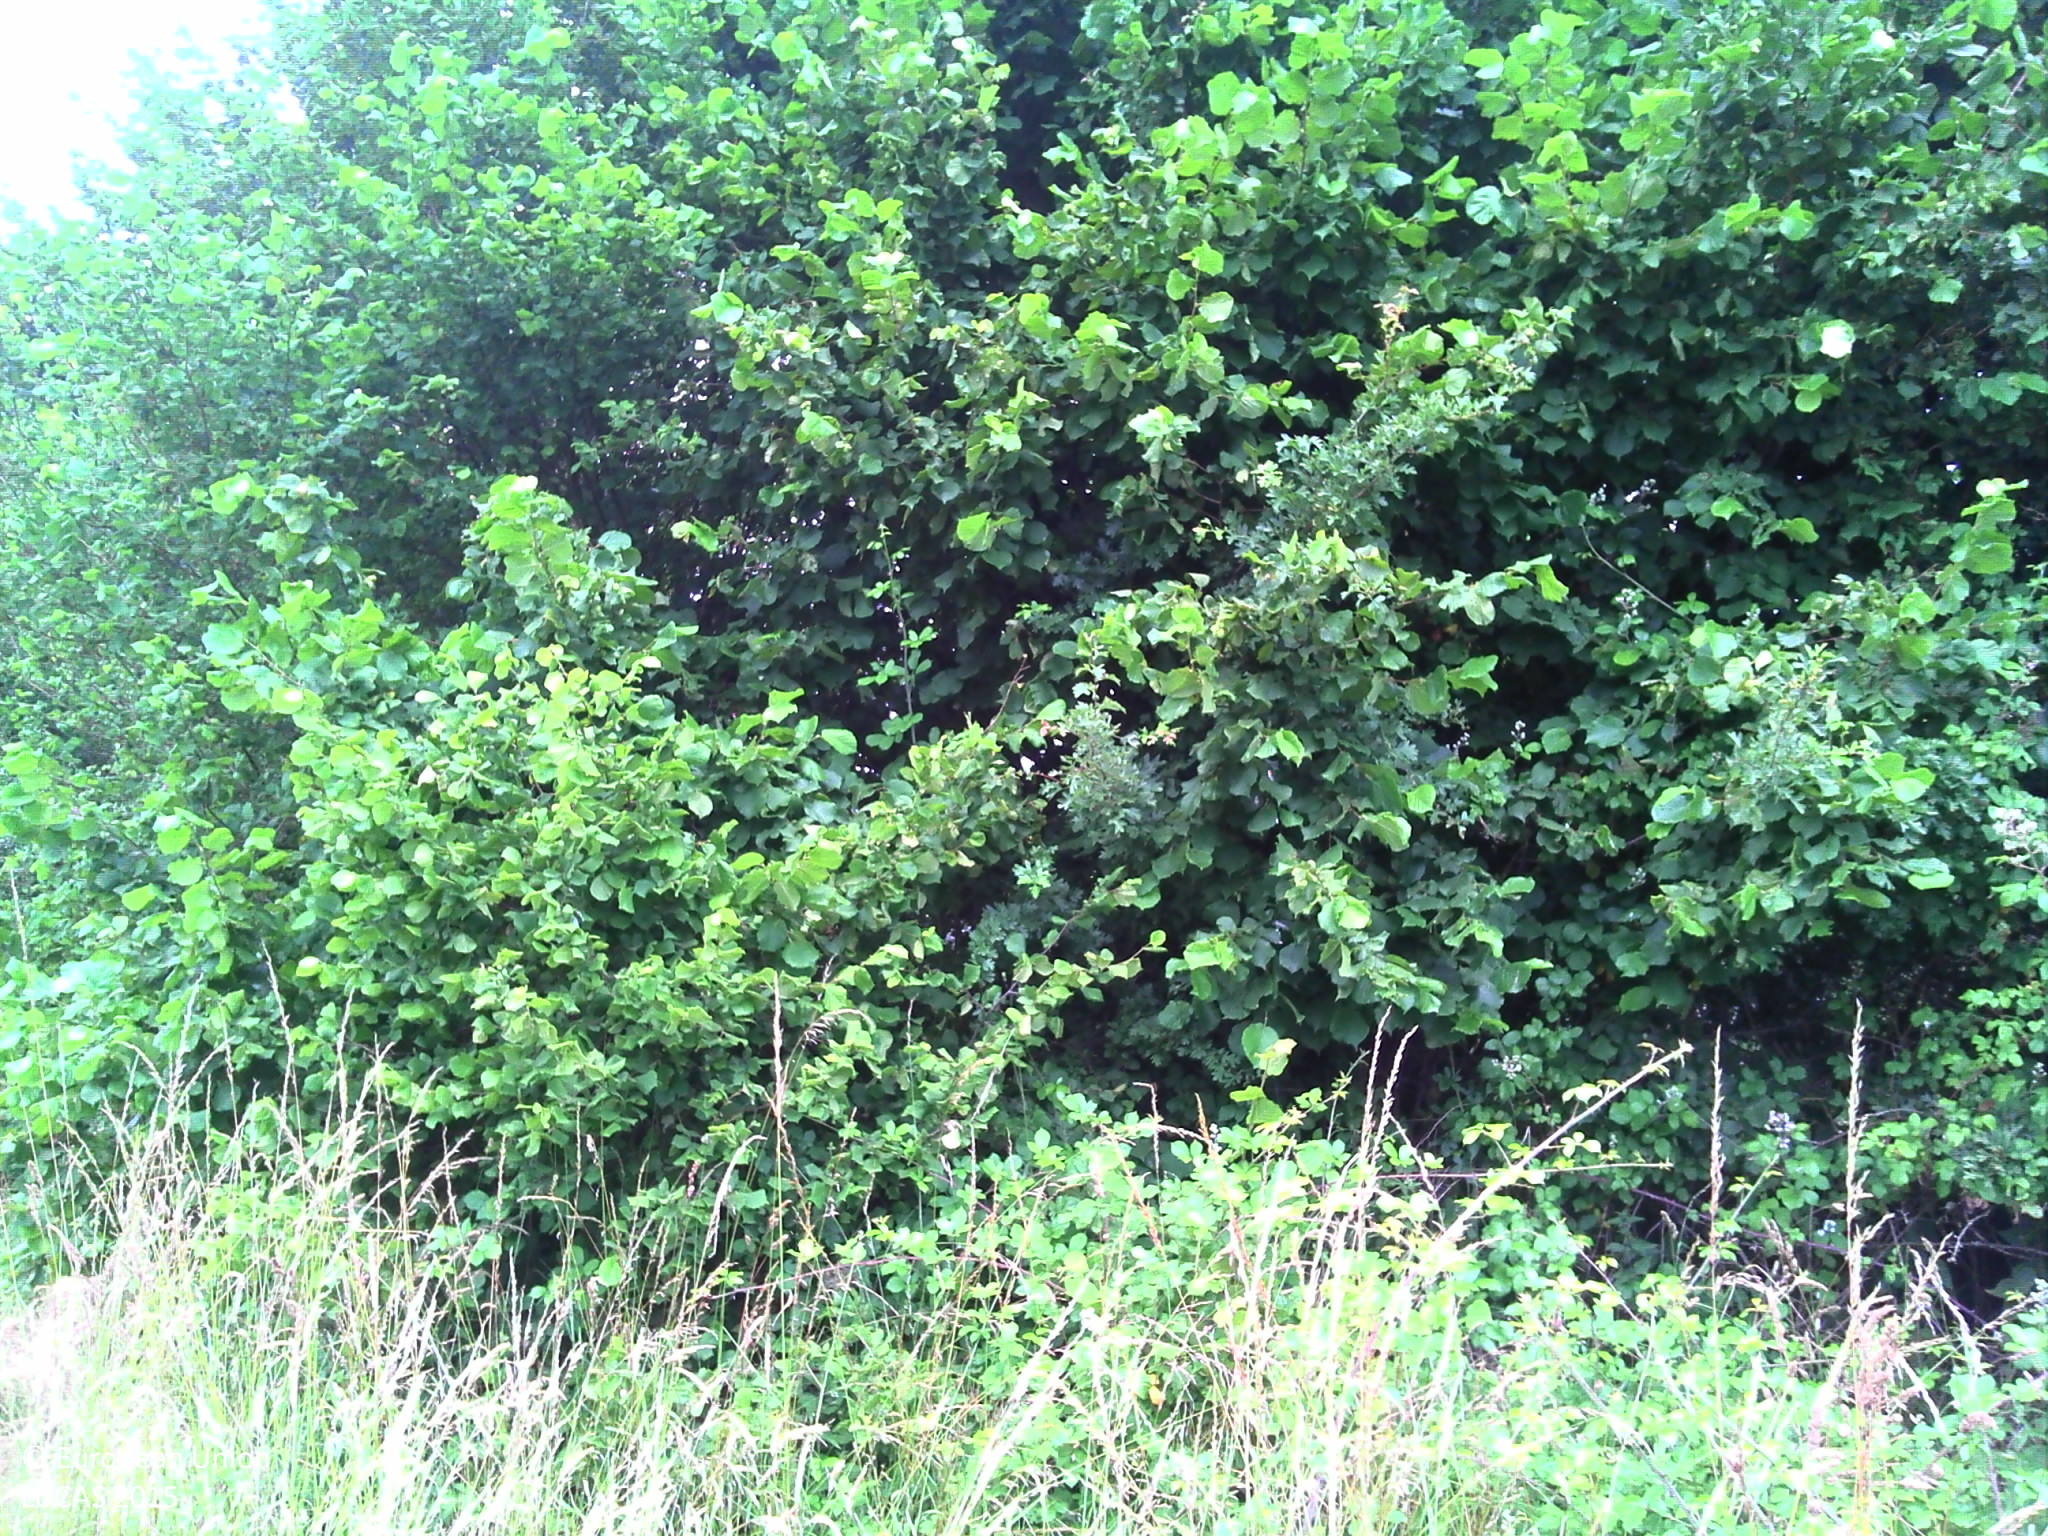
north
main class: Cropland
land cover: Potatoes
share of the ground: > 75 %
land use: Kitchen garden
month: June
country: FR
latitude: 47.8279
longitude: 0.2637
